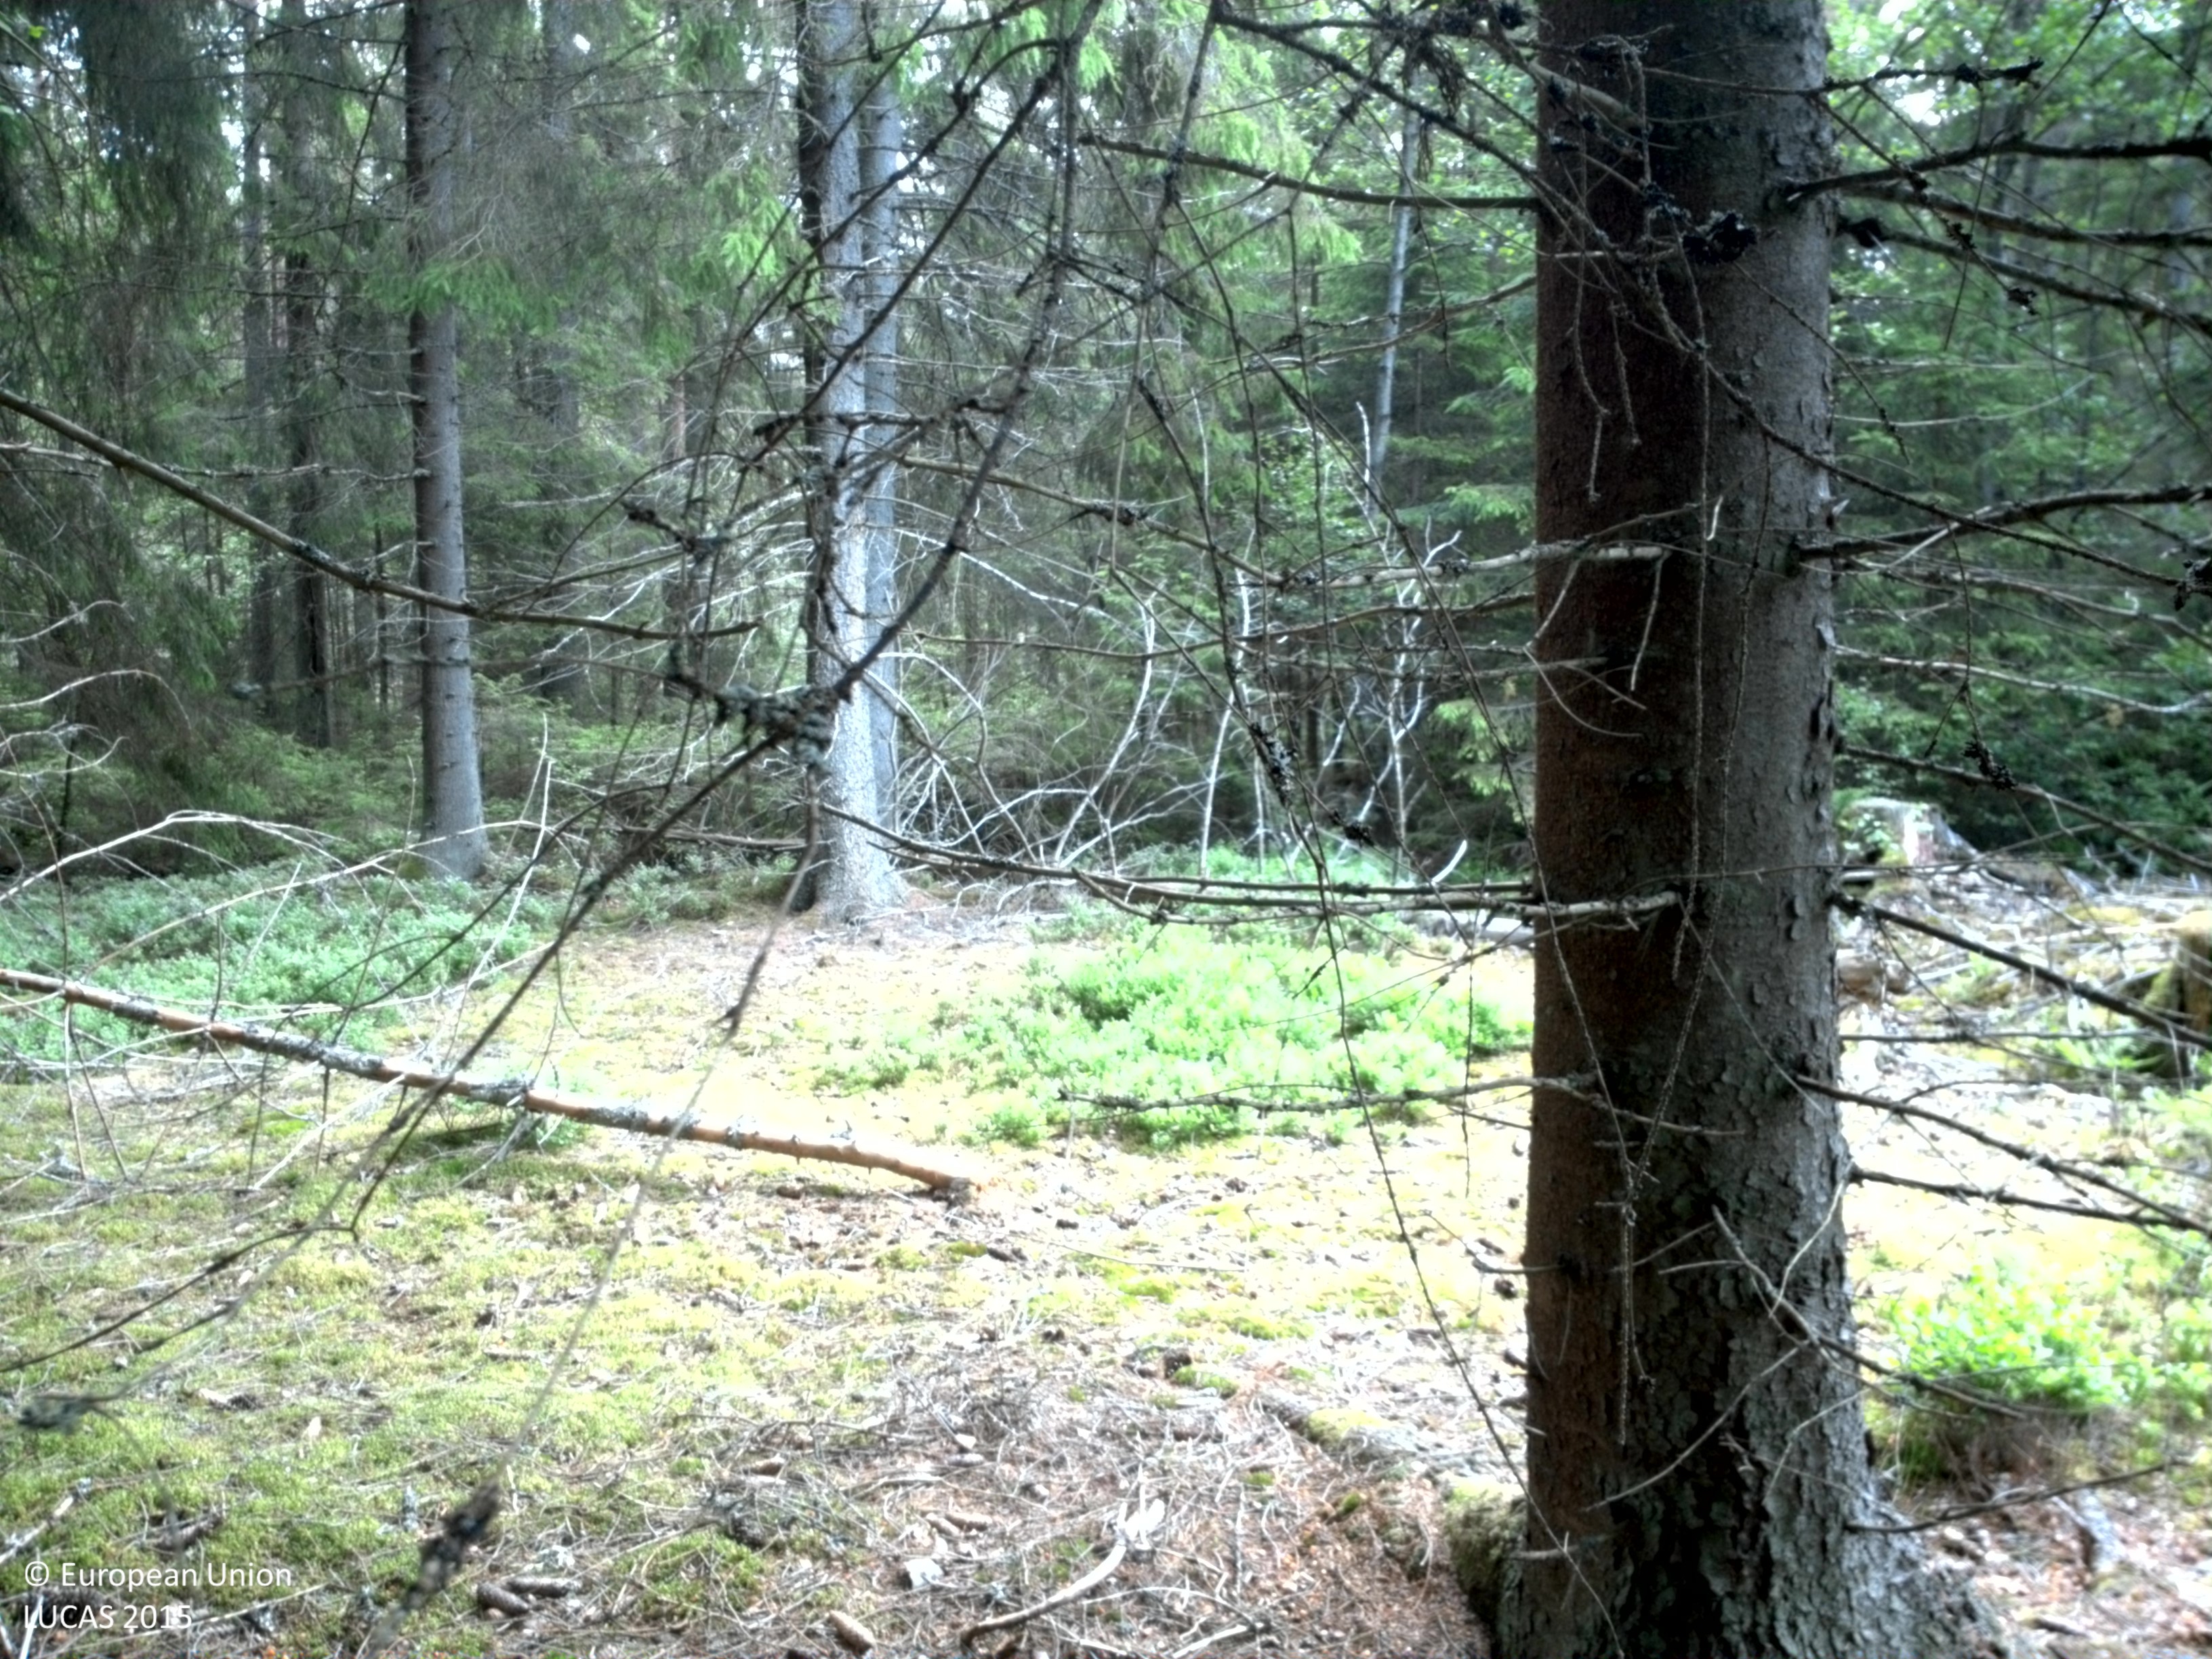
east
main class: Woodland
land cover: Spruce dominated coniferous woodland
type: boreal forest
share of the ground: 25 - 50 %
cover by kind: coniferous forest trees 50 %, lichens and mosses 20 %, consolidated bare surface 20 %, herbaceous plants 10 %
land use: Forestry
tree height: > 5 m
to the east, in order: Spruce dominated coniferous woodland; Spruce dominated mixed woodland; Ditches and canals; Spruce dominated coniferous woodland; Pine dominated coniferous woodland; Ditches and canals; Spruce dominated coniferous woodland; Spruce dominated mixed woodland
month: June
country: SE
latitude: 58.5754
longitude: 15.5139
